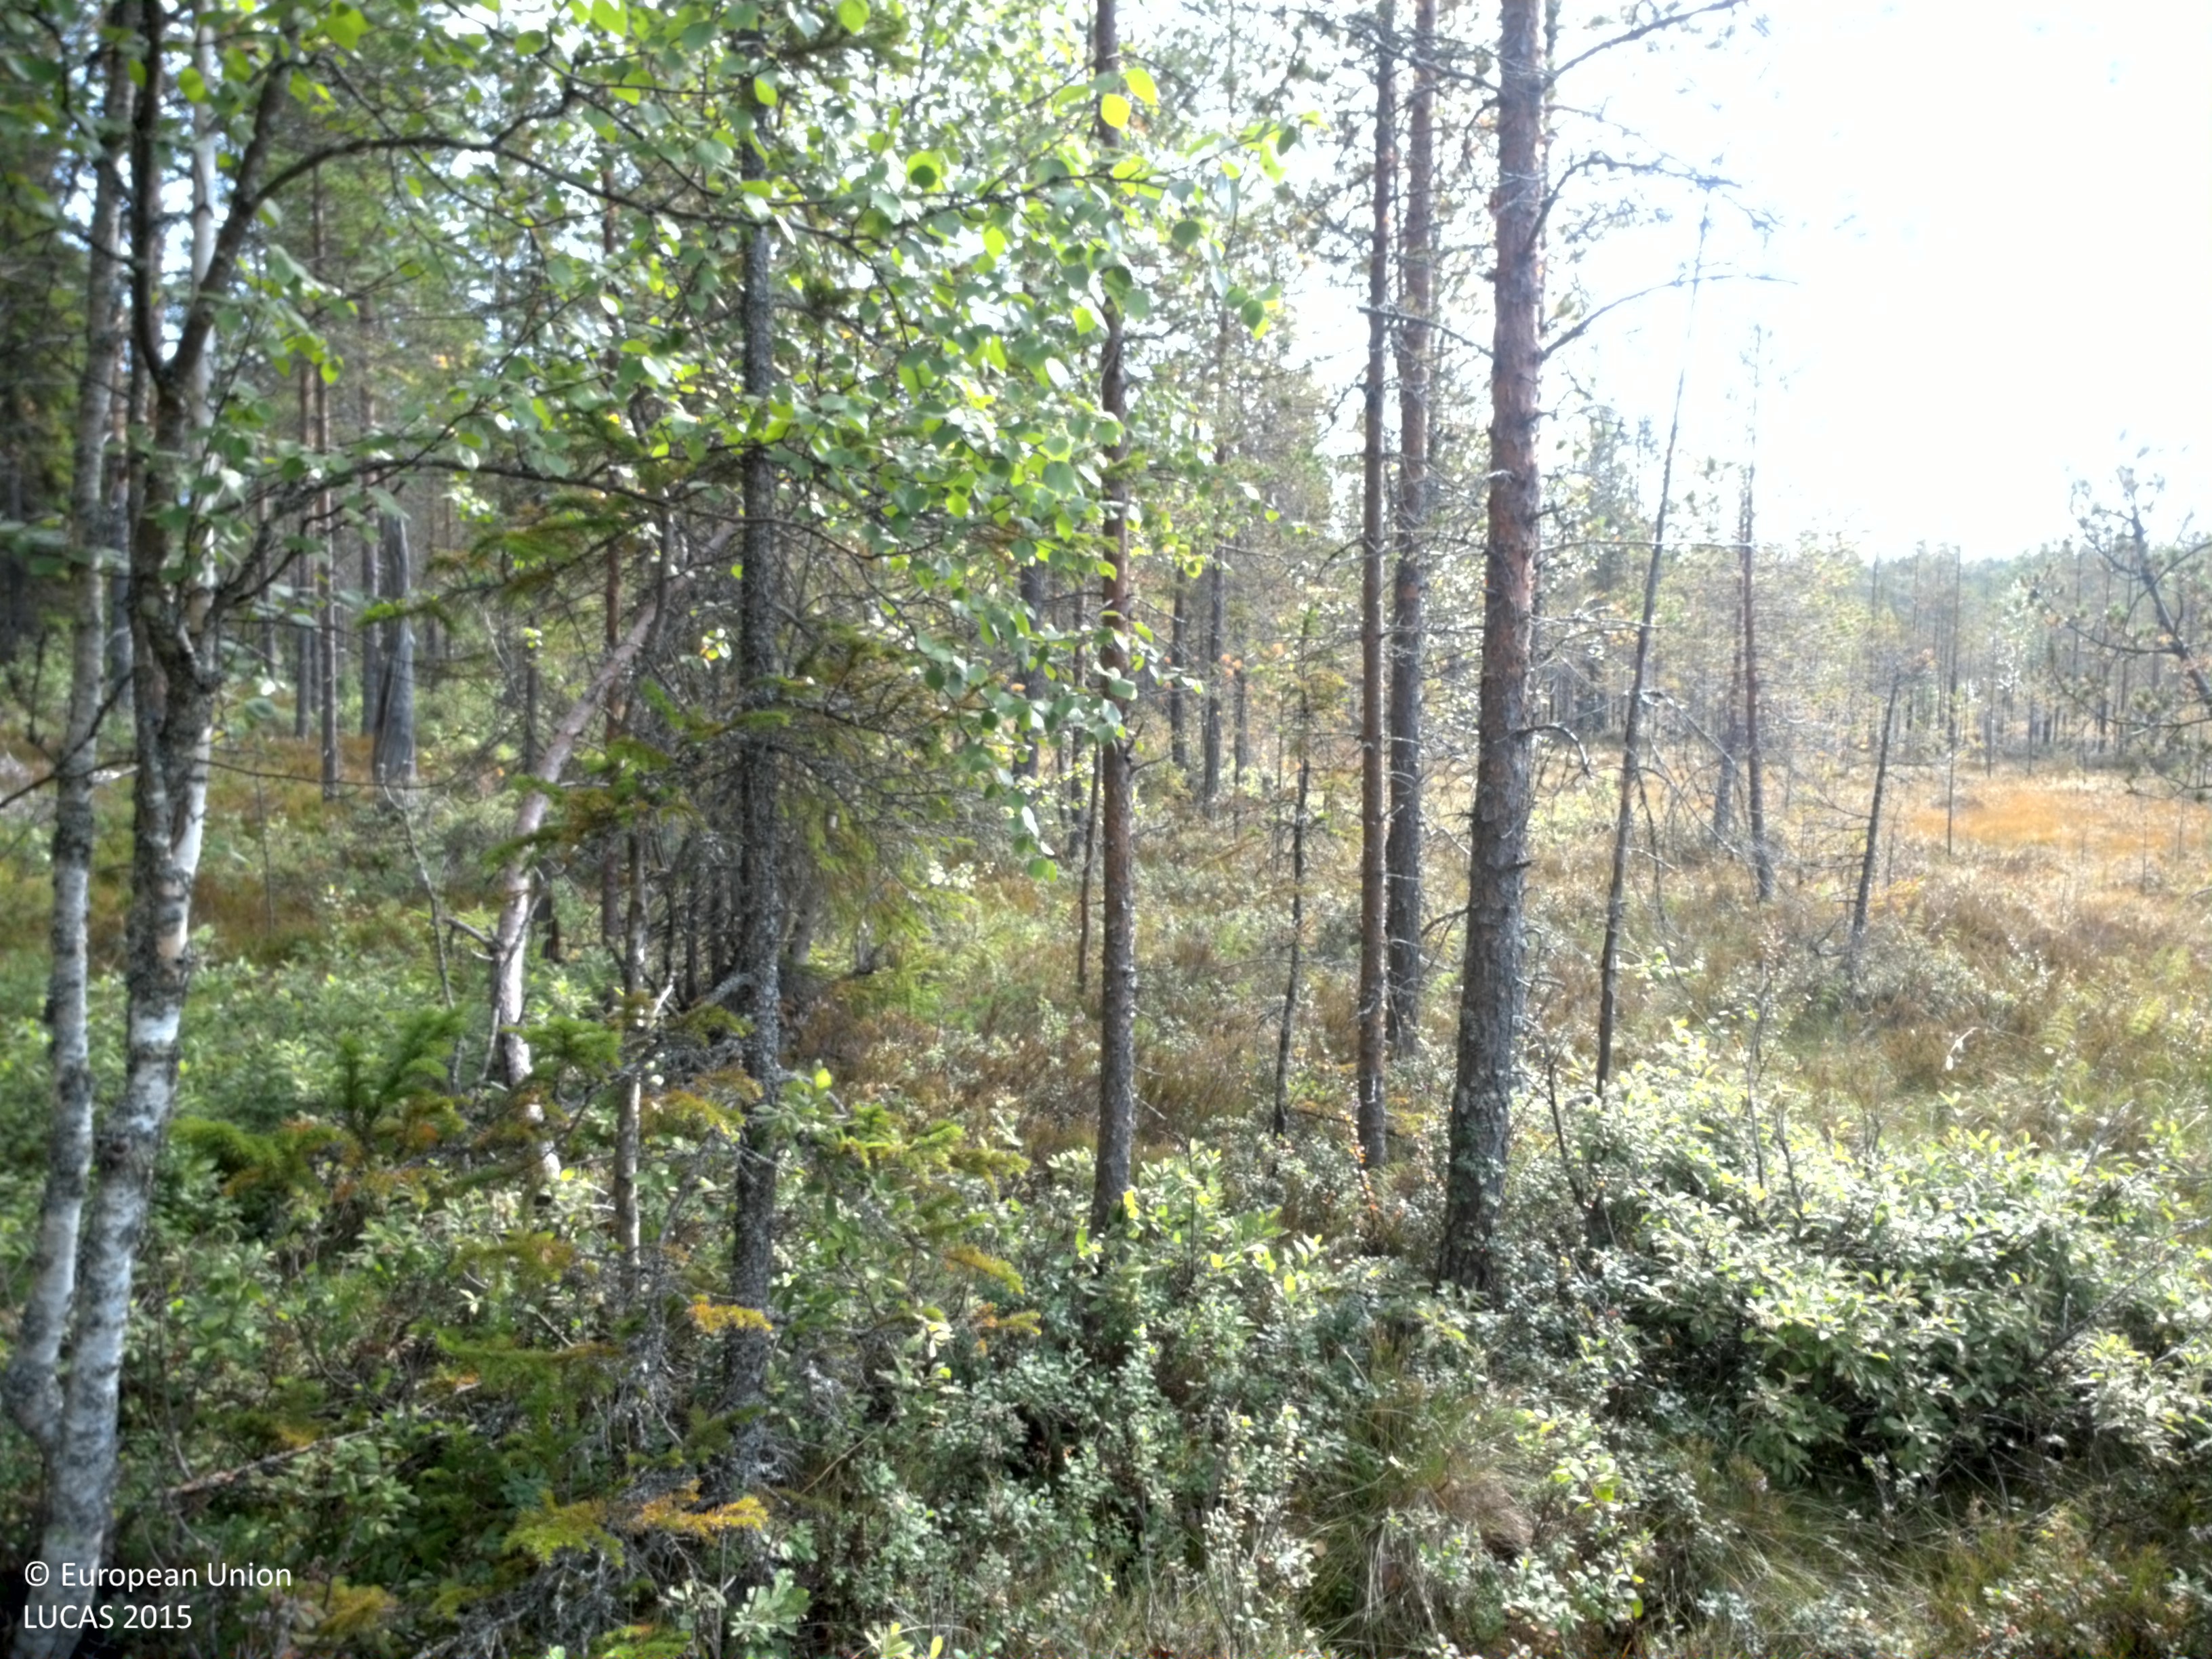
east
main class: Woodland
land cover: Pine dominated mixed woodland
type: boreal forest
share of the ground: 25 - 50 %
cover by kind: coniferous forest trees 35 %, lichens and mosses 25 %, shrubs 20 %, broadleaved forest trees 15 %, herbaceous plants 5 %
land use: Forestry
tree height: > 5 m
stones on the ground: < 10 %
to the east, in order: Pine dominated mixed woodland; Other mixed woodland; Paved roads, cycling and walking lanes; Other mixed woodland; Pine dominated coniferous woodland
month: August
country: SE
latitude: 61.8628
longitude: 14.9443
